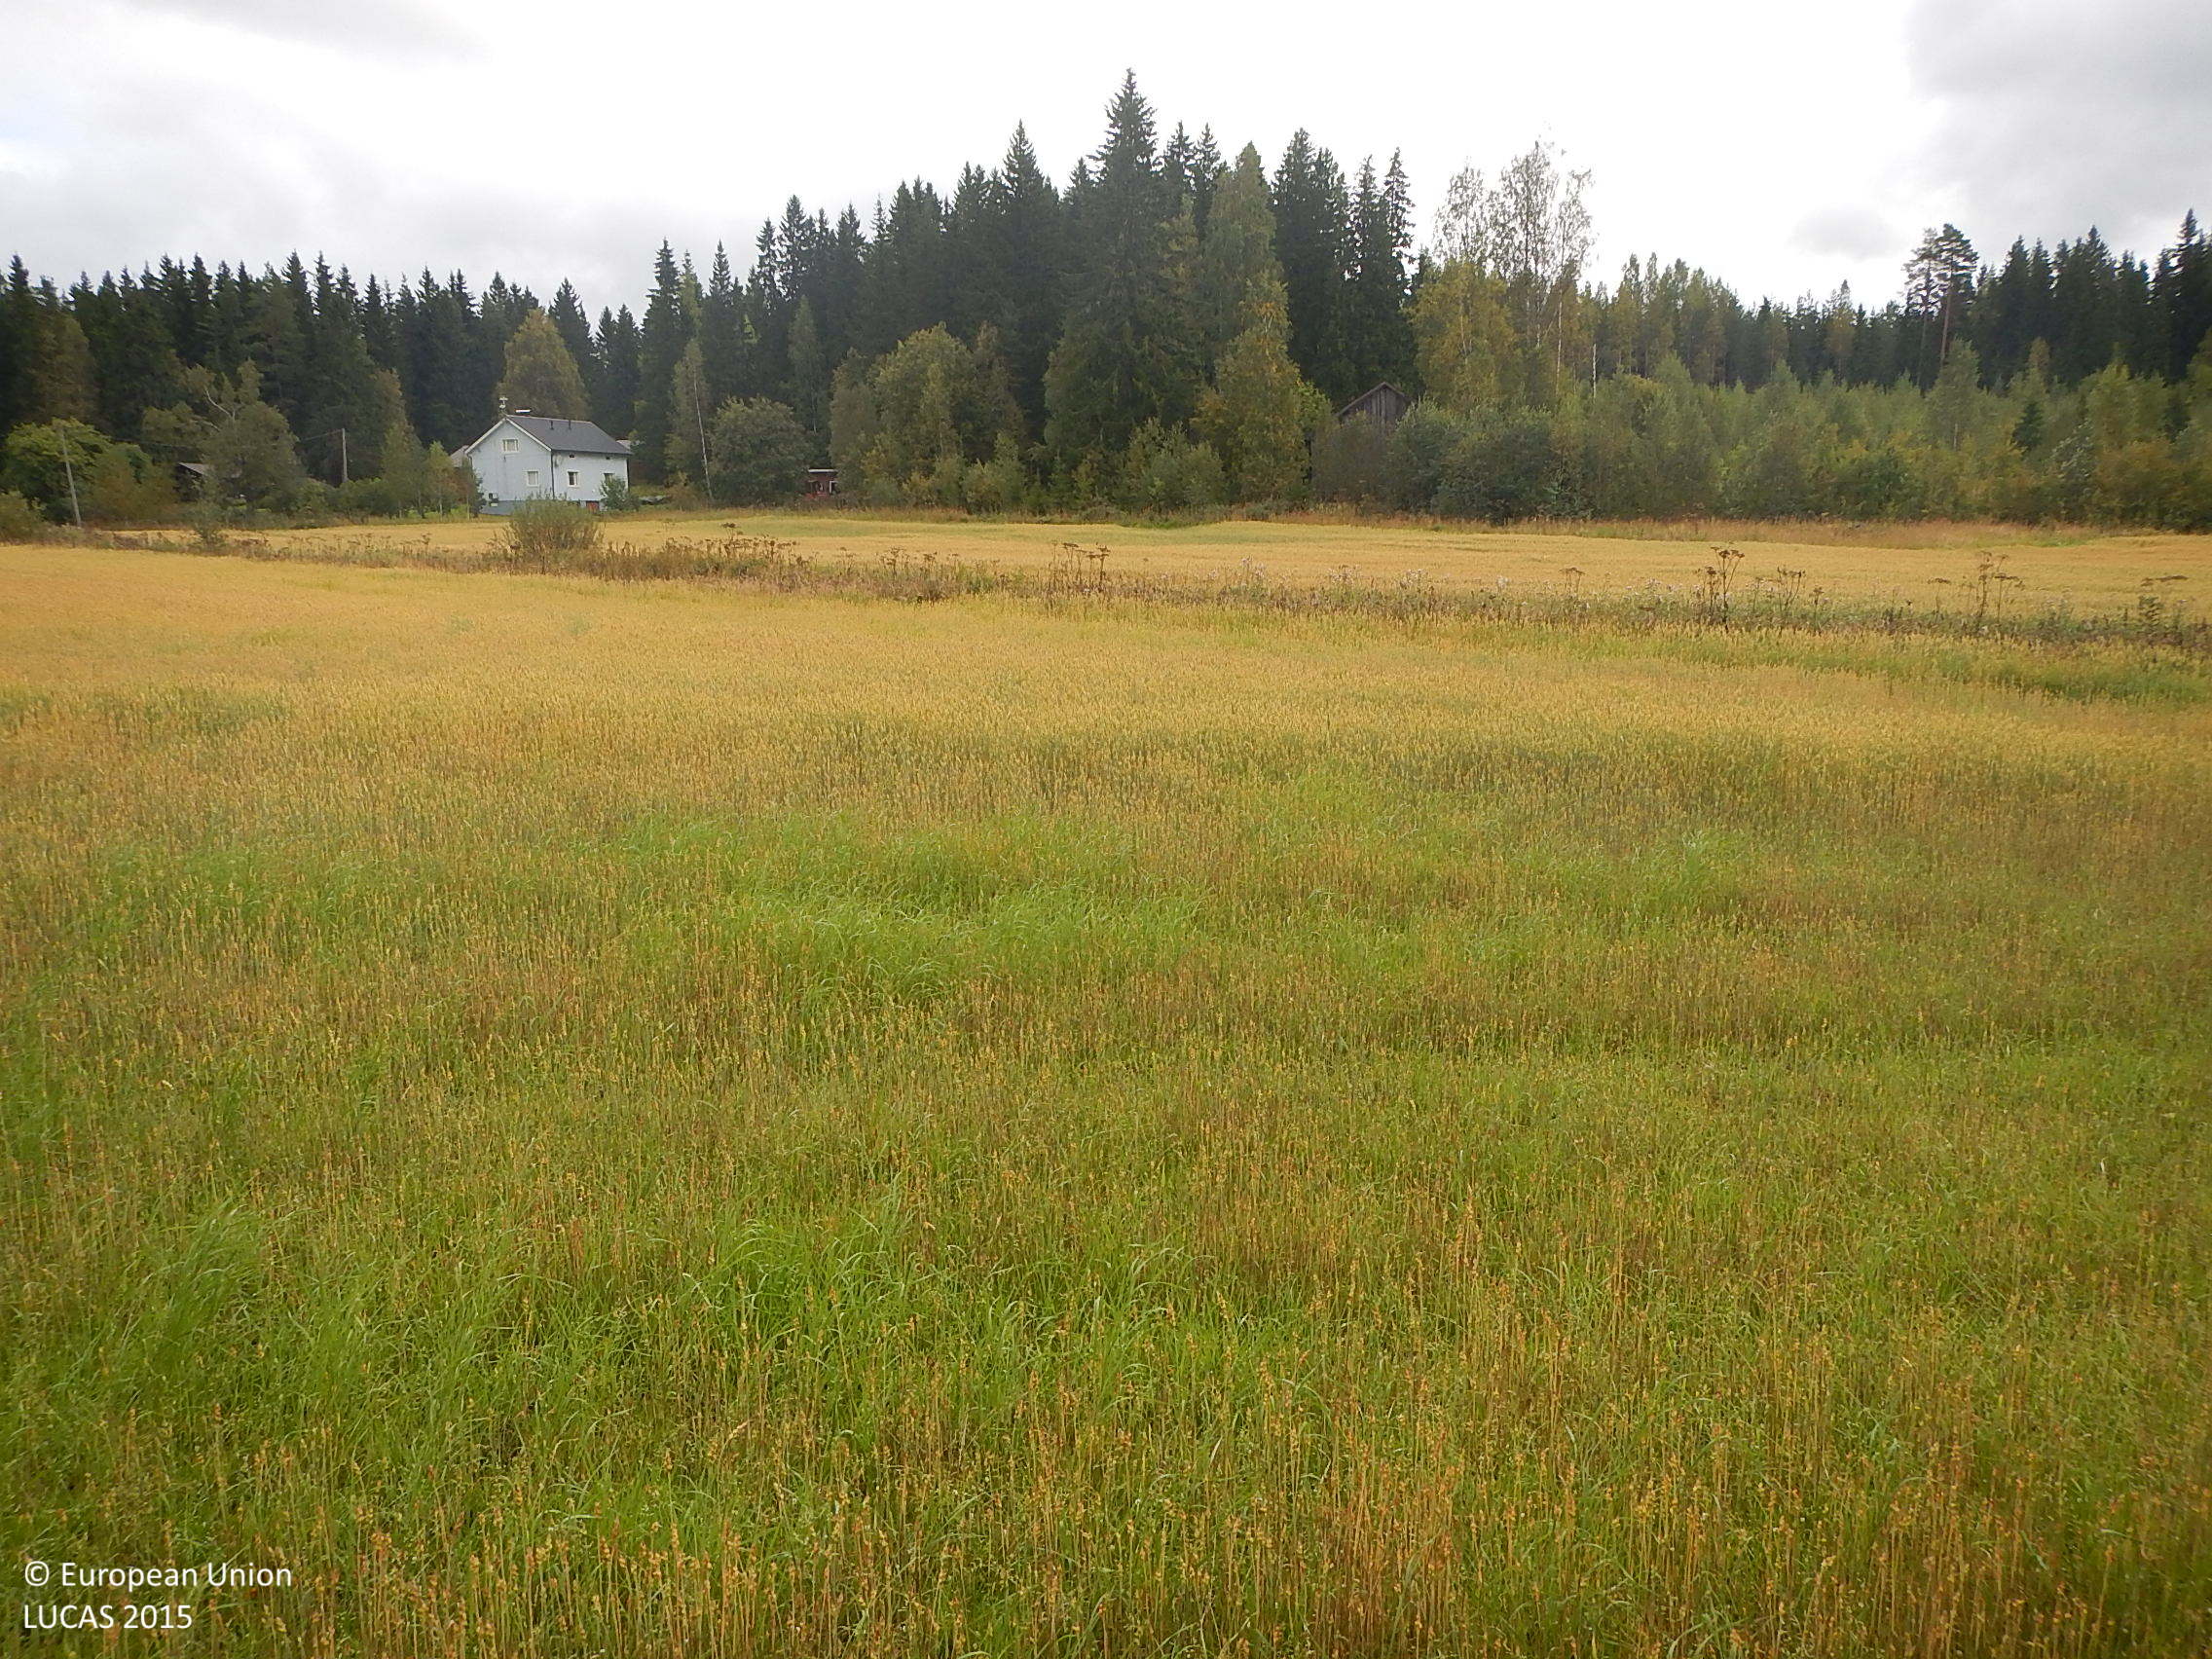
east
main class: Cropland
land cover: Common wheat
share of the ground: 25 - 50 %
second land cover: Spontaneously vegetated surfaces
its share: 50 - 75 %
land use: Agriculture (excluding fallow land and kitchen gardens)
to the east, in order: Common wheat; Spontaneously vegetated surfaces; Grass margins; Ditches and canals; Grass margins; Common wheat; Grass margins; Ditches and canals; Spruce dominated mixed woodland; Tracks; Spruce dominated coniferous woodland; Broadleaved woodland; Spruce dominated mixed woodland
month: September
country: FI
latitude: 61.4860
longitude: 22.7044
